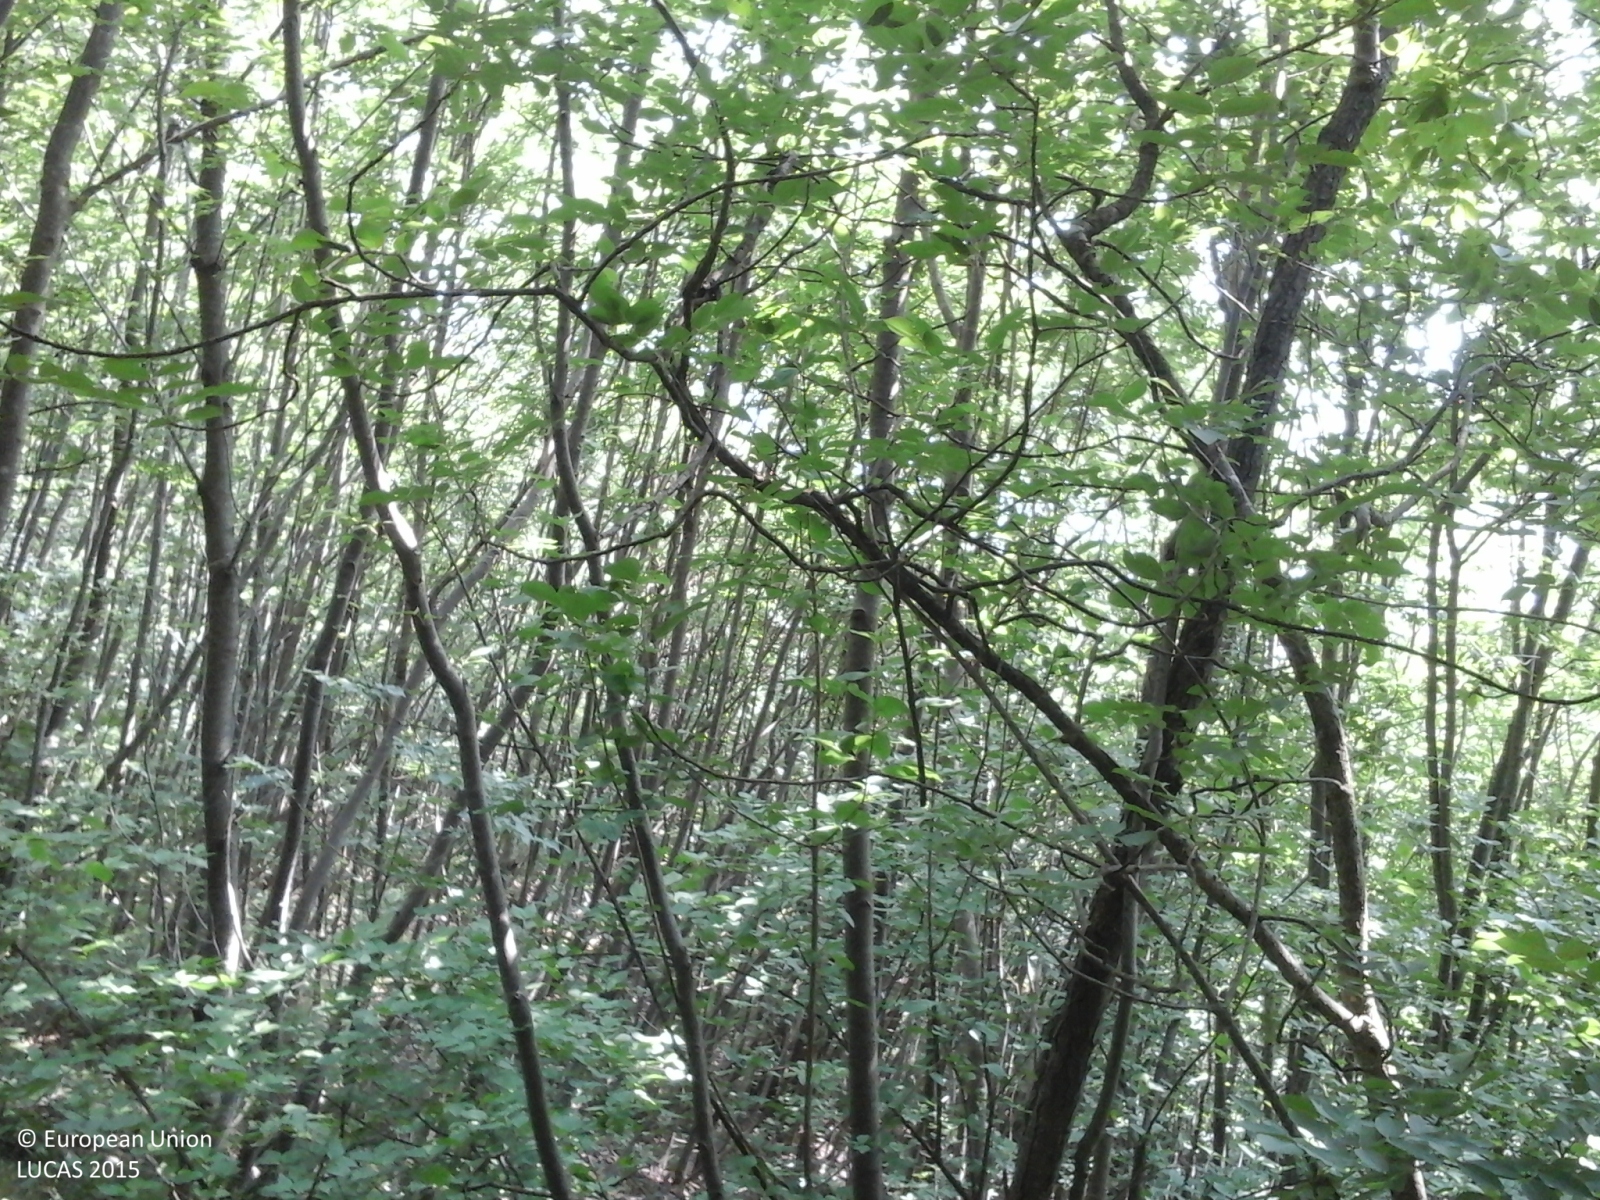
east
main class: Woodland
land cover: Broadleaved woodland
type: thermophilous deciduous forest
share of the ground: > 75 %
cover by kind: broadleaved forest trees 100 %
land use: Forestry
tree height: > 5 m
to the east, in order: Broadleaved woodland; Rocks and stones; Broadleaved woodland
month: June
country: IT
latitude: 46.0033
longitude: 11.0960
